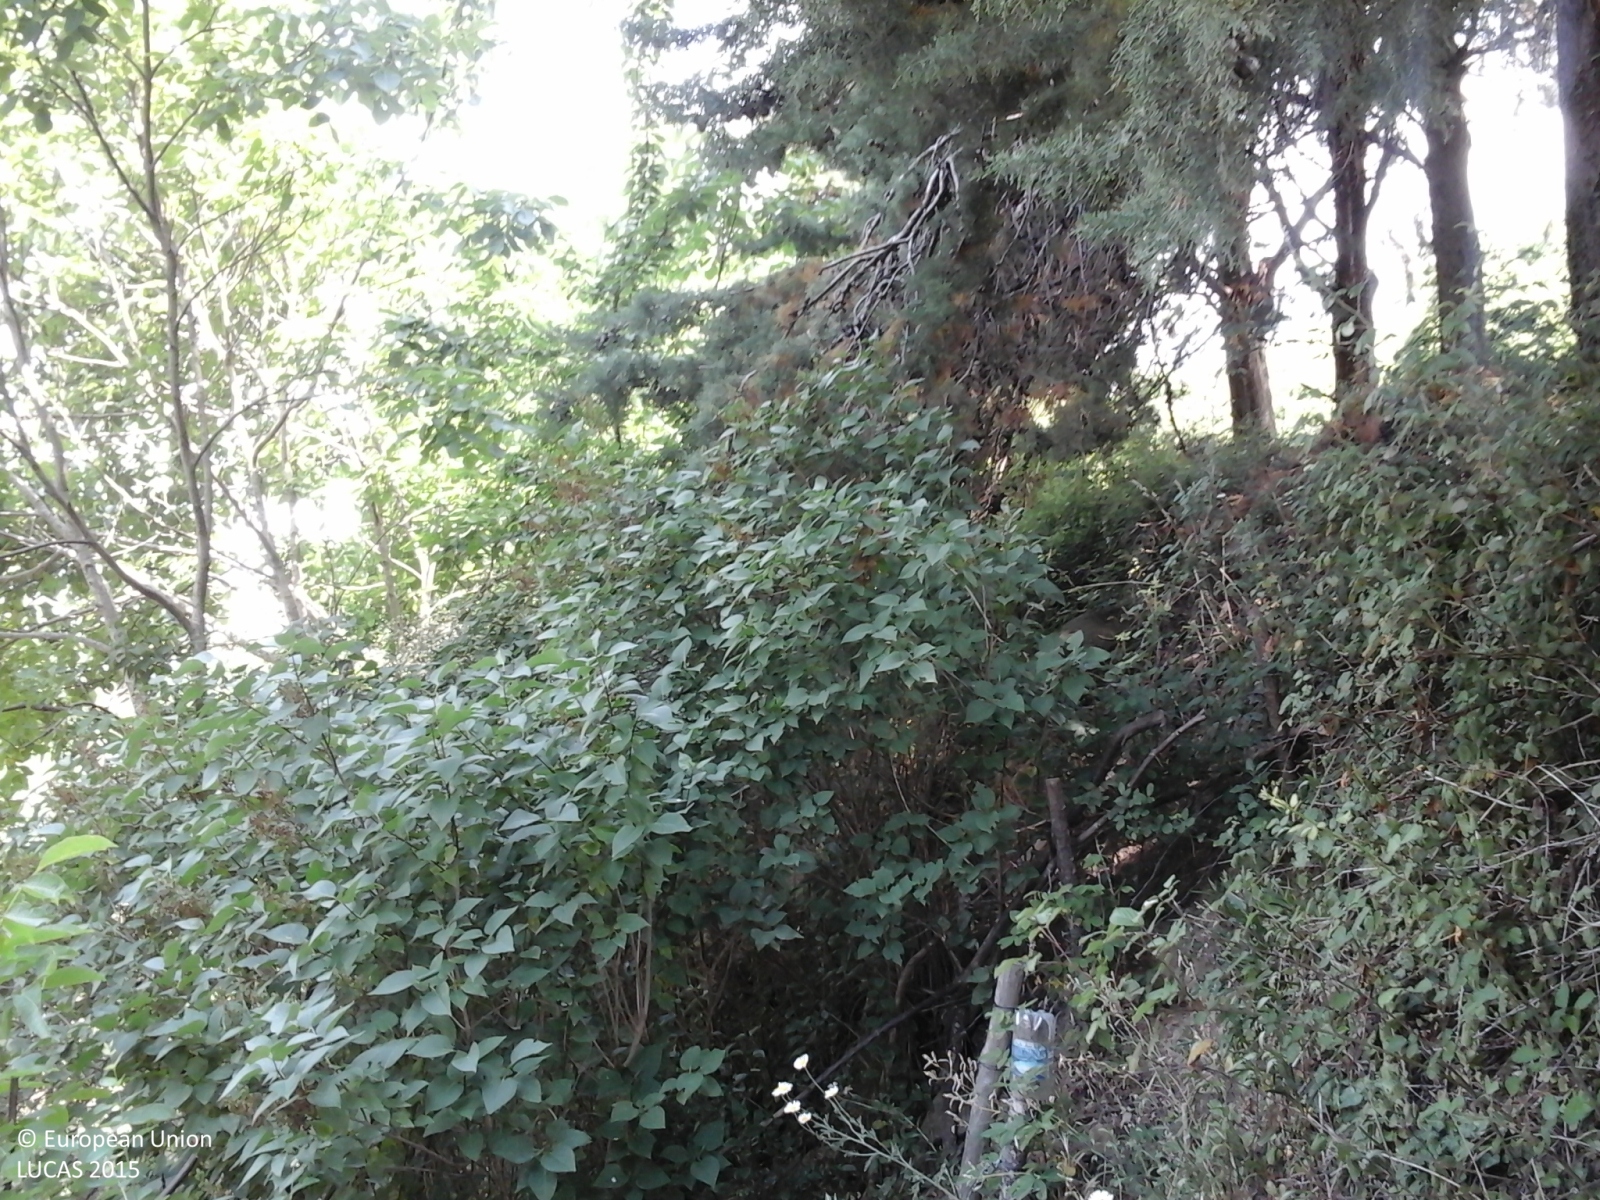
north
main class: Shrubland
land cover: Shrubland with sparse tree cover
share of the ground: > 75 %
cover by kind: shrubs 85 %, herbaceous plants 10 %, broadleaved forest trees 5 %
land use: Semi-natural and natural areas not in use
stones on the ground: < 10 %
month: June
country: IT
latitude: 43.8334
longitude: 11.5754
